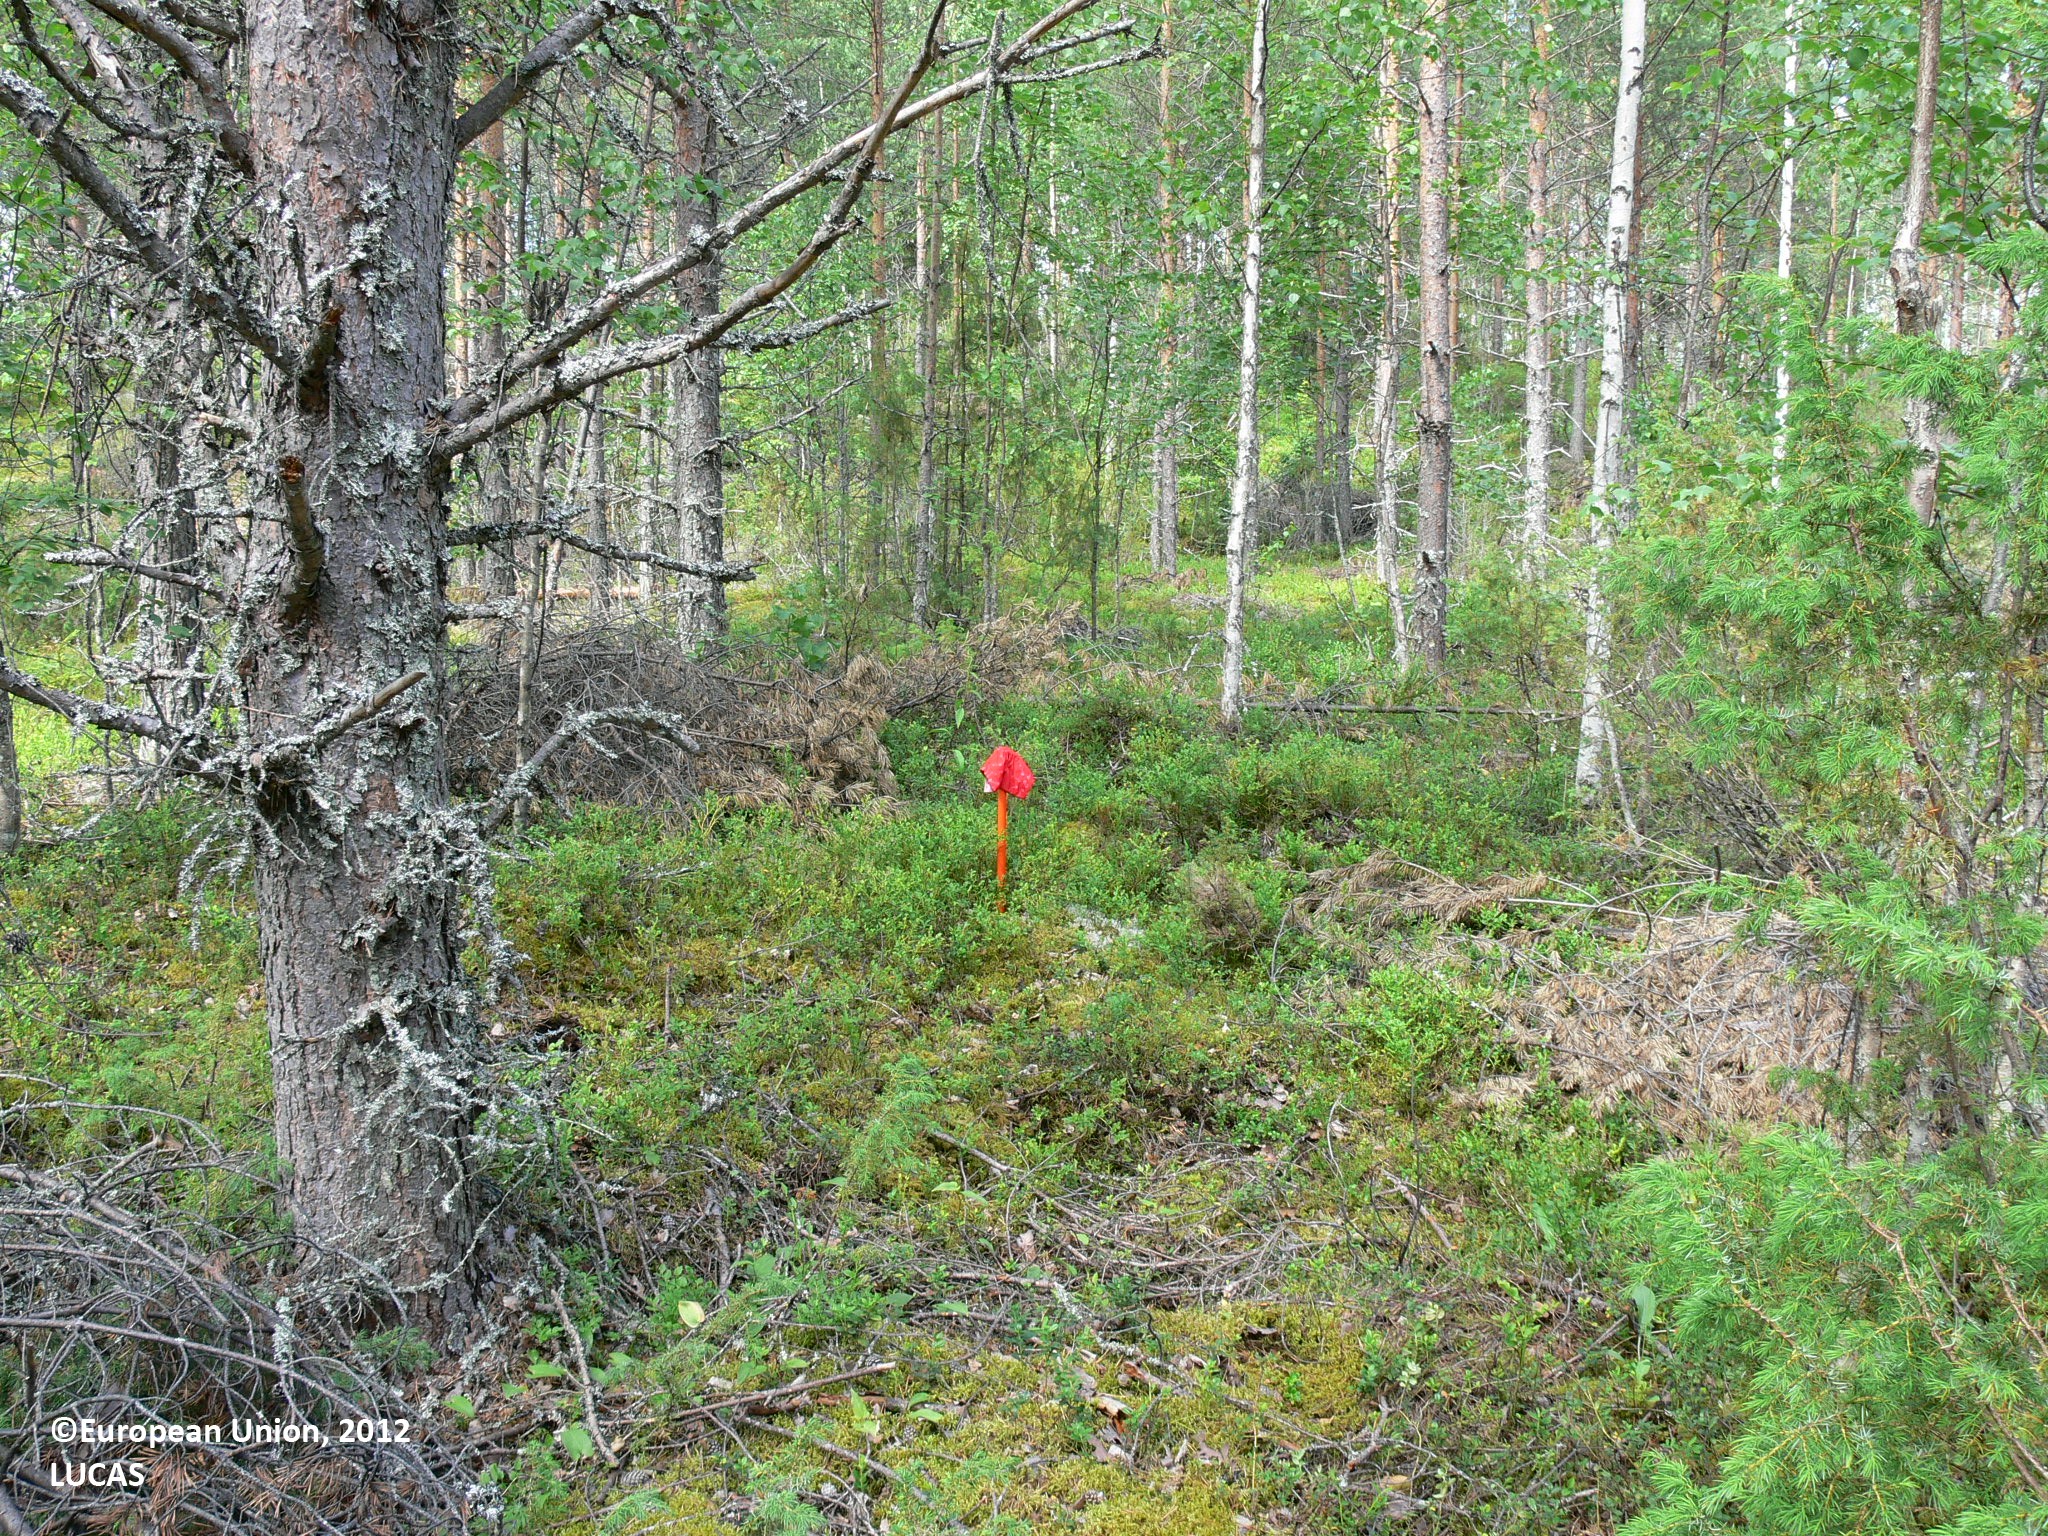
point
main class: Woodland
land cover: Pine dominated mixed woodland
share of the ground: 50 - 75 %
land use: Forestry
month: July
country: FI
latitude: 63.0380
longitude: 30.8730
